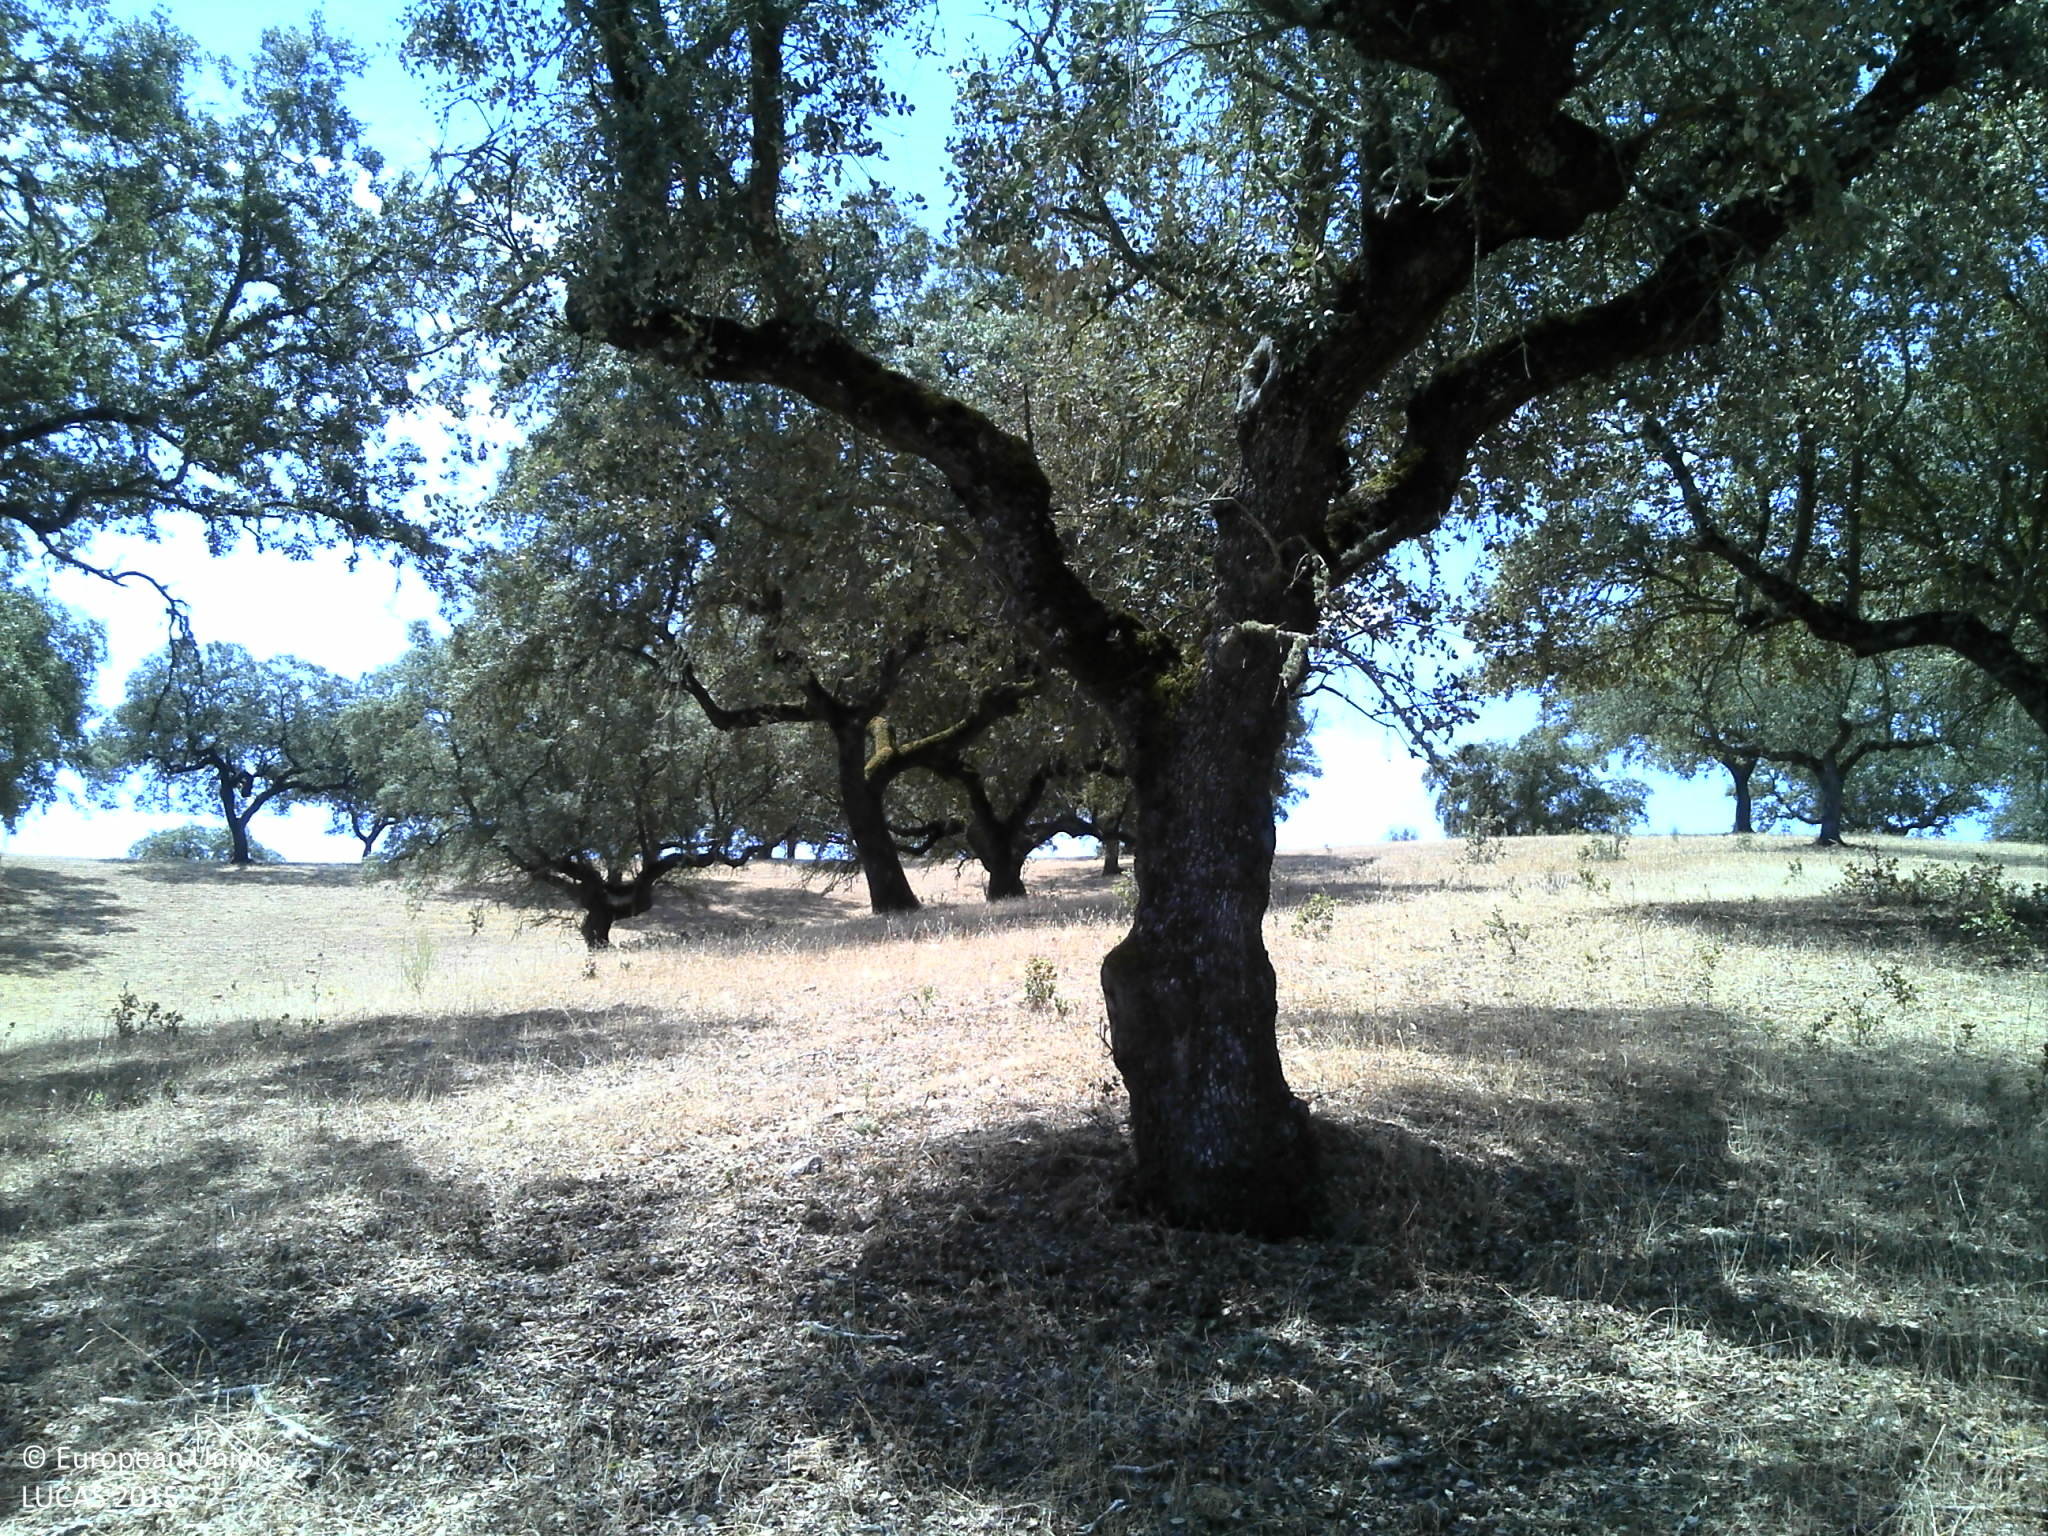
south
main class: Woodland
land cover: Broadleaved woodland
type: broadleaved evergreen forest
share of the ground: 25 - 50 %
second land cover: Grassland without tree/shrub cover
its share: 25 - 50 %
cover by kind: broadleaved forest trees 40 %, unconsolidated bare surface 35 %, herbaceous plants 25 %
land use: Forestry
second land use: Agriculture (excluding fallow land and kitchen gardens)
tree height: > 5 m
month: July
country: PT
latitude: 38.4819
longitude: -7.6746
